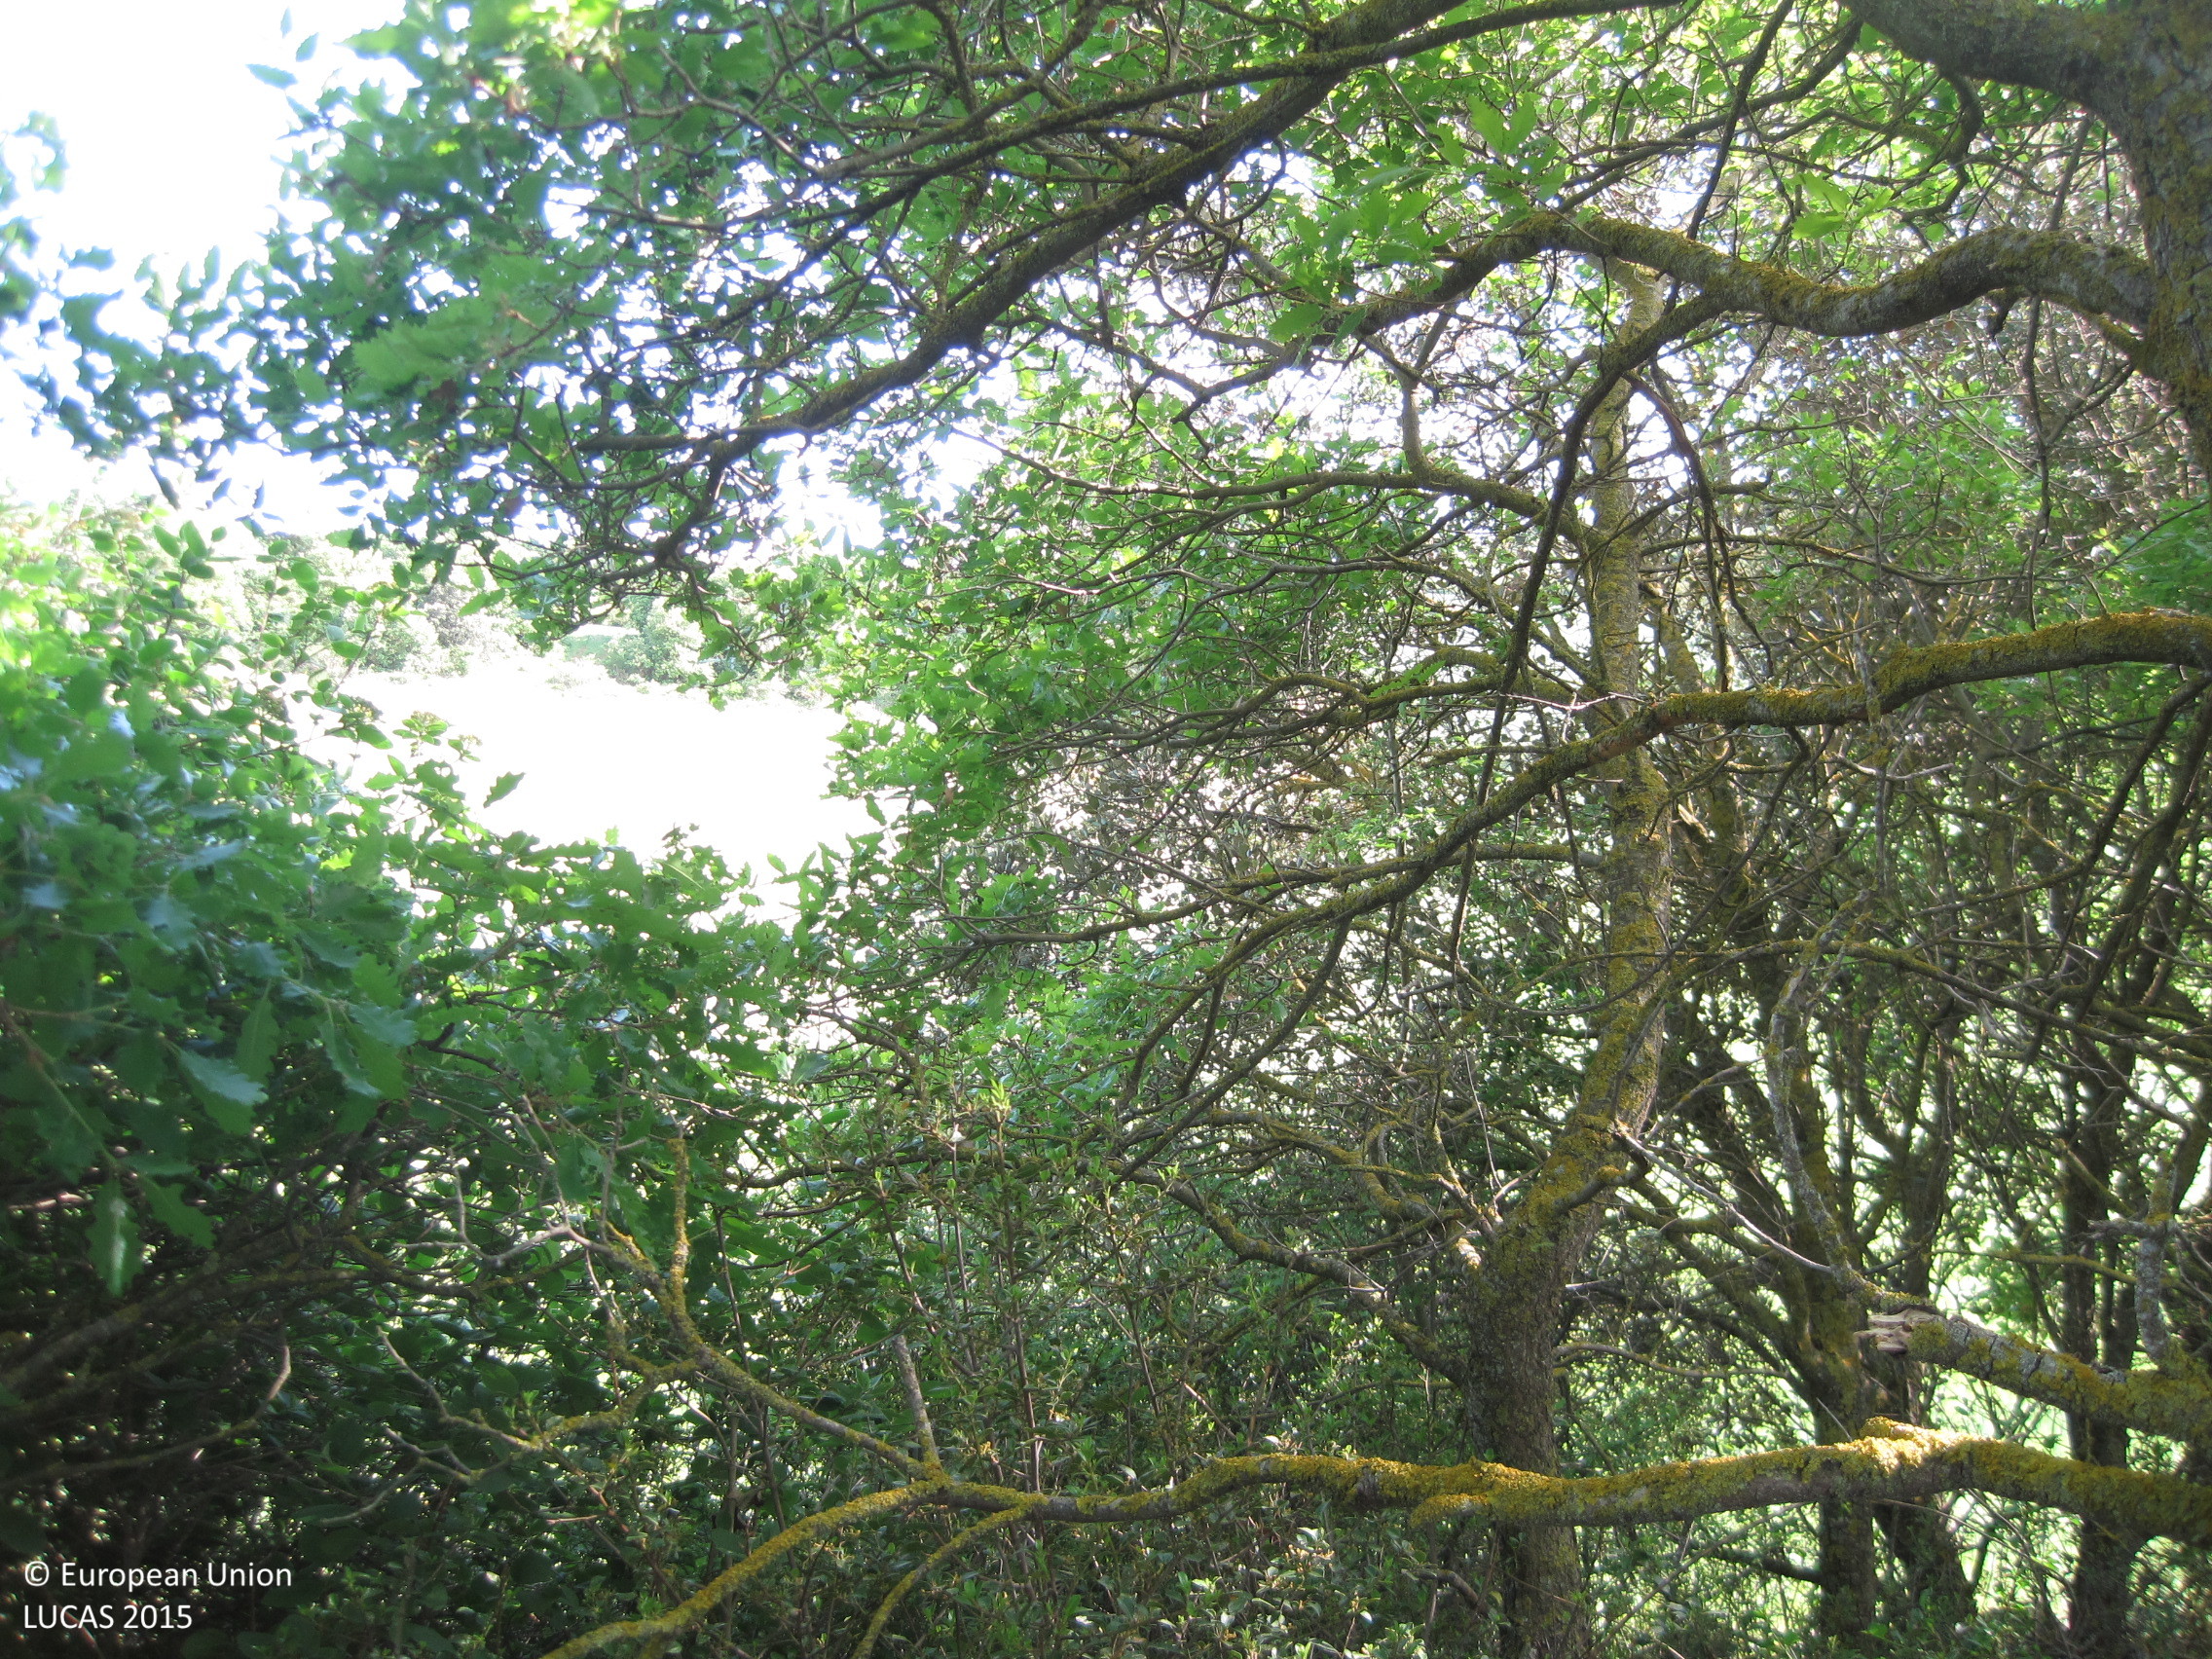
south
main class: Woodland
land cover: Broadleaved woodland
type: acidophilous oak and oak-birch forest
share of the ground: > 75 %
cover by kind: broadleaved forest trees 100 %
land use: Semi-natural and natural areas not in use
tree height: > 5 m
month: May
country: ES
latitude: 42.6522
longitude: -1.6627
